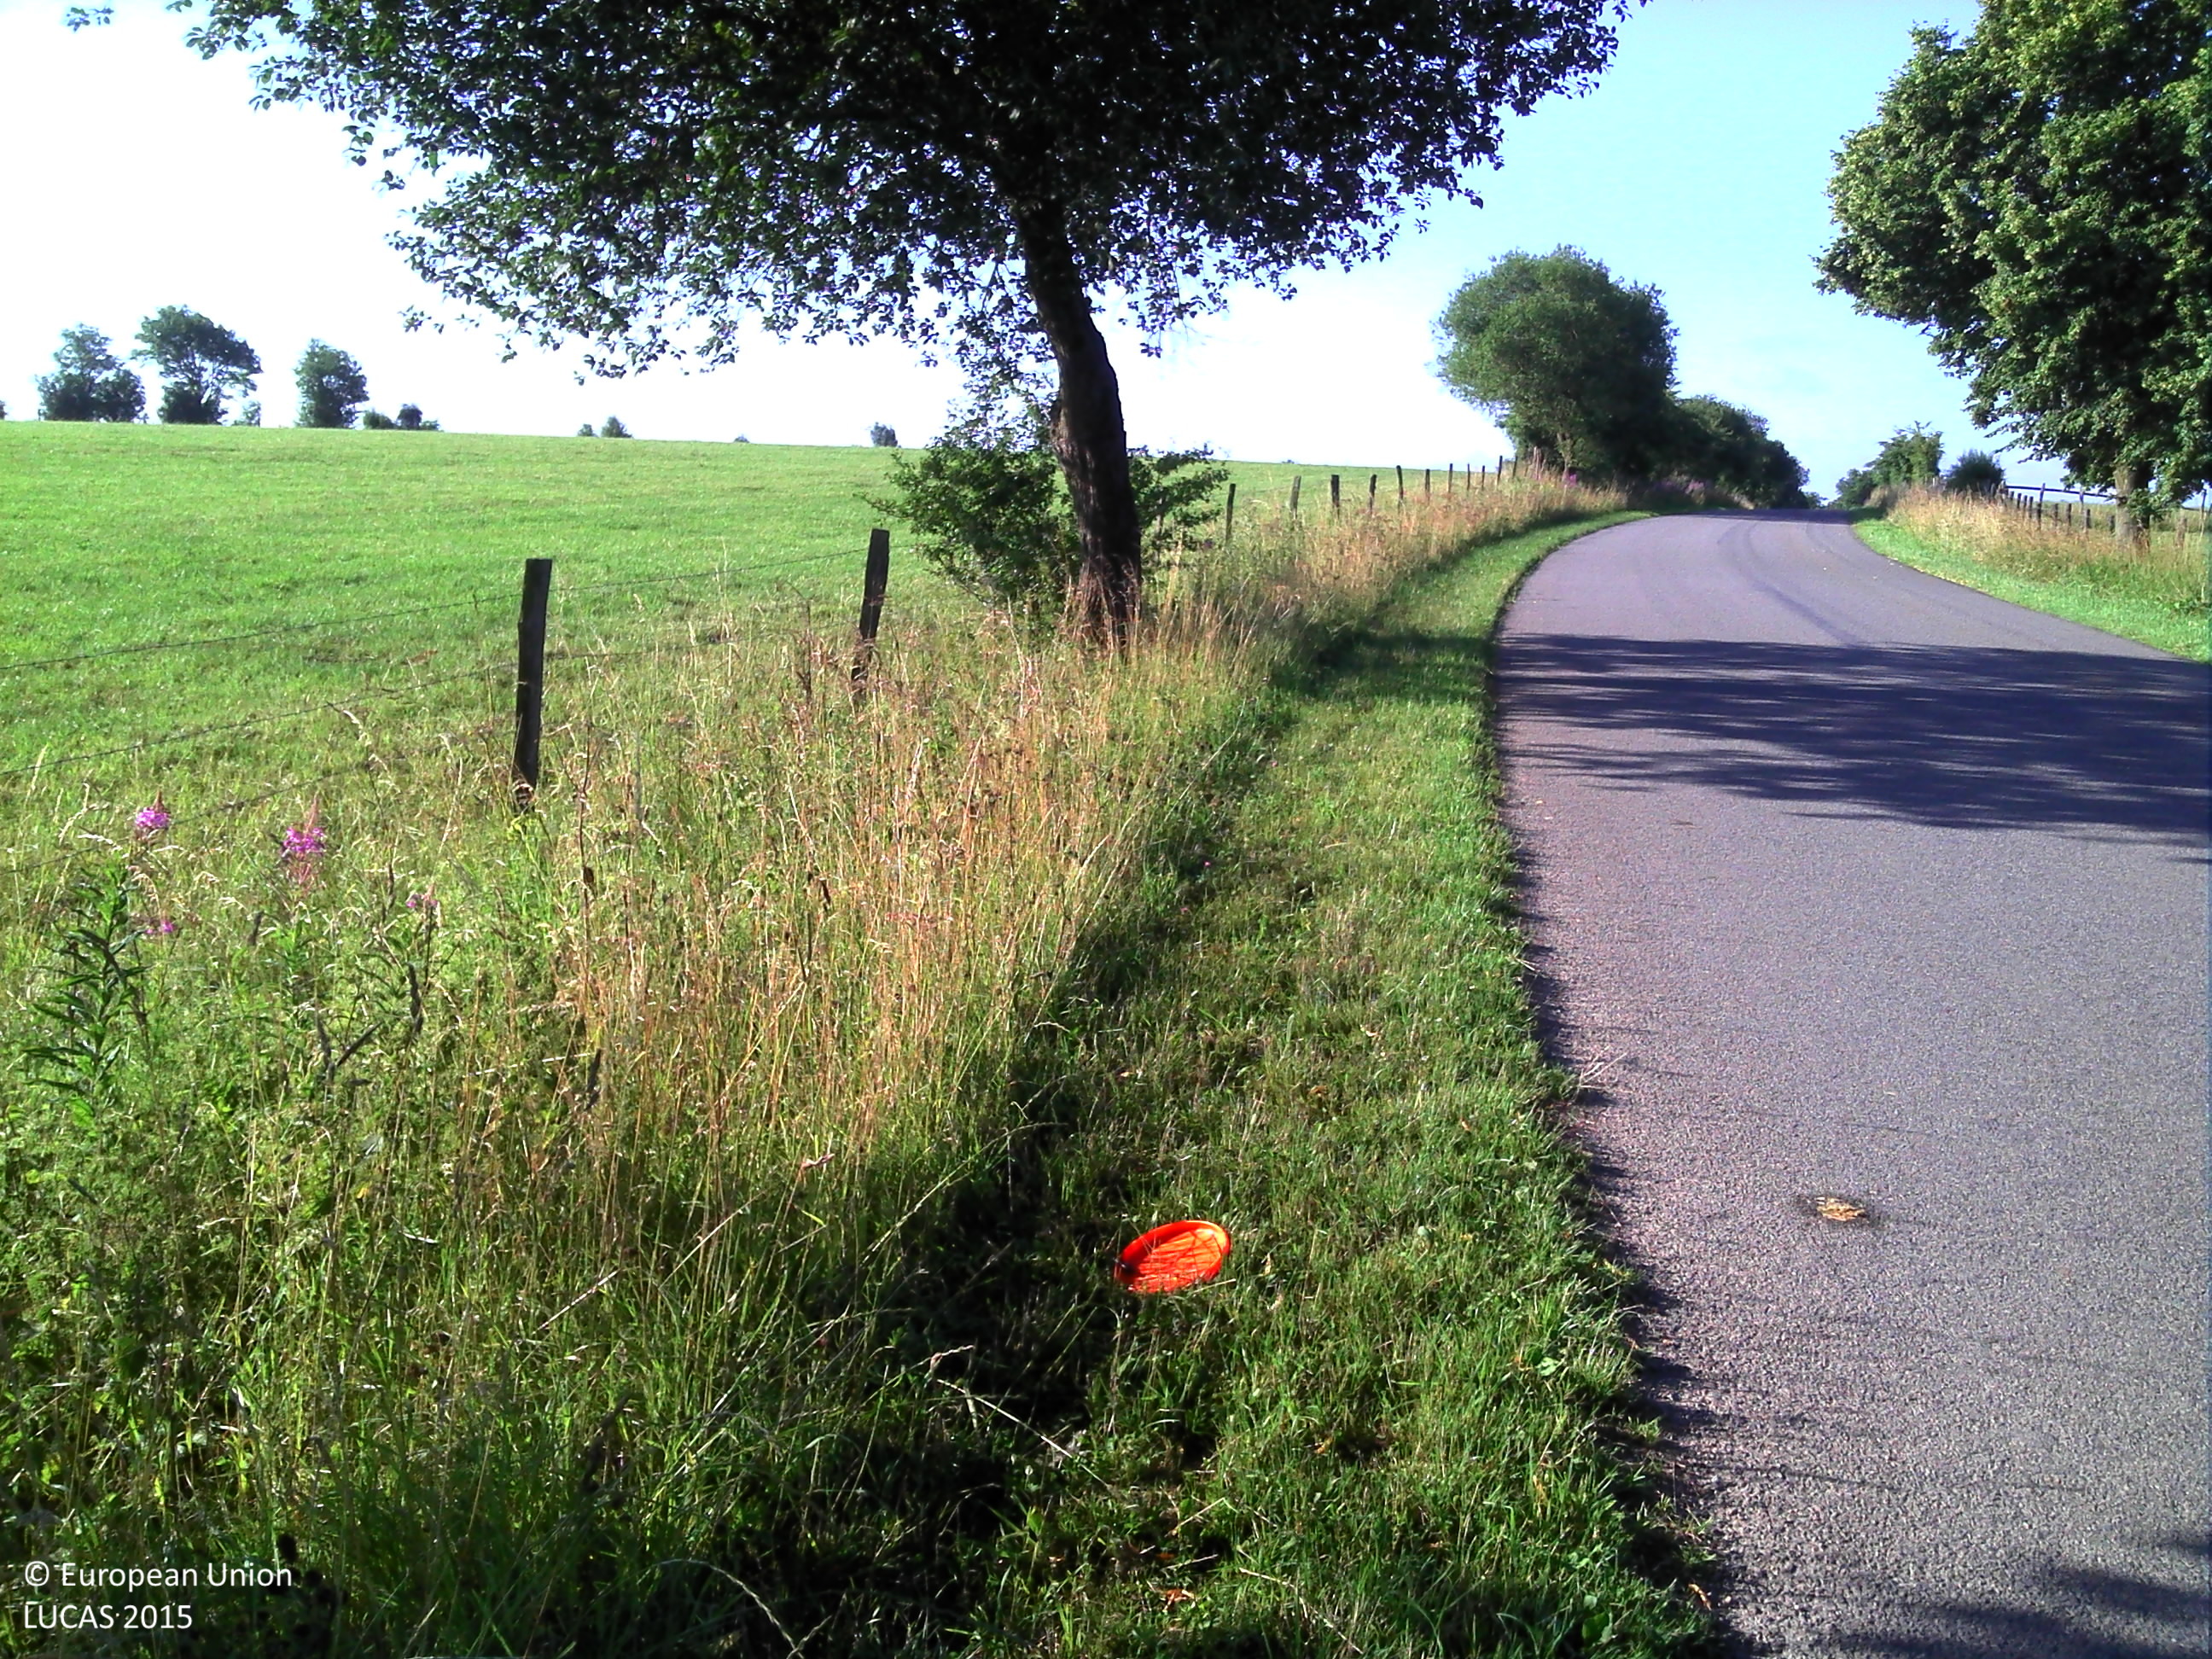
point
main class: Grassland
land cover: Grassland without tree/shrub cover
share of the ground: > 75 %
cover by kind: herbaceous plants 100 %
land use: Agriculture (excluding fallow land and kitchen gardens)
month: July
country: BE
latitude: 50.3735
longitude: 6.2170
